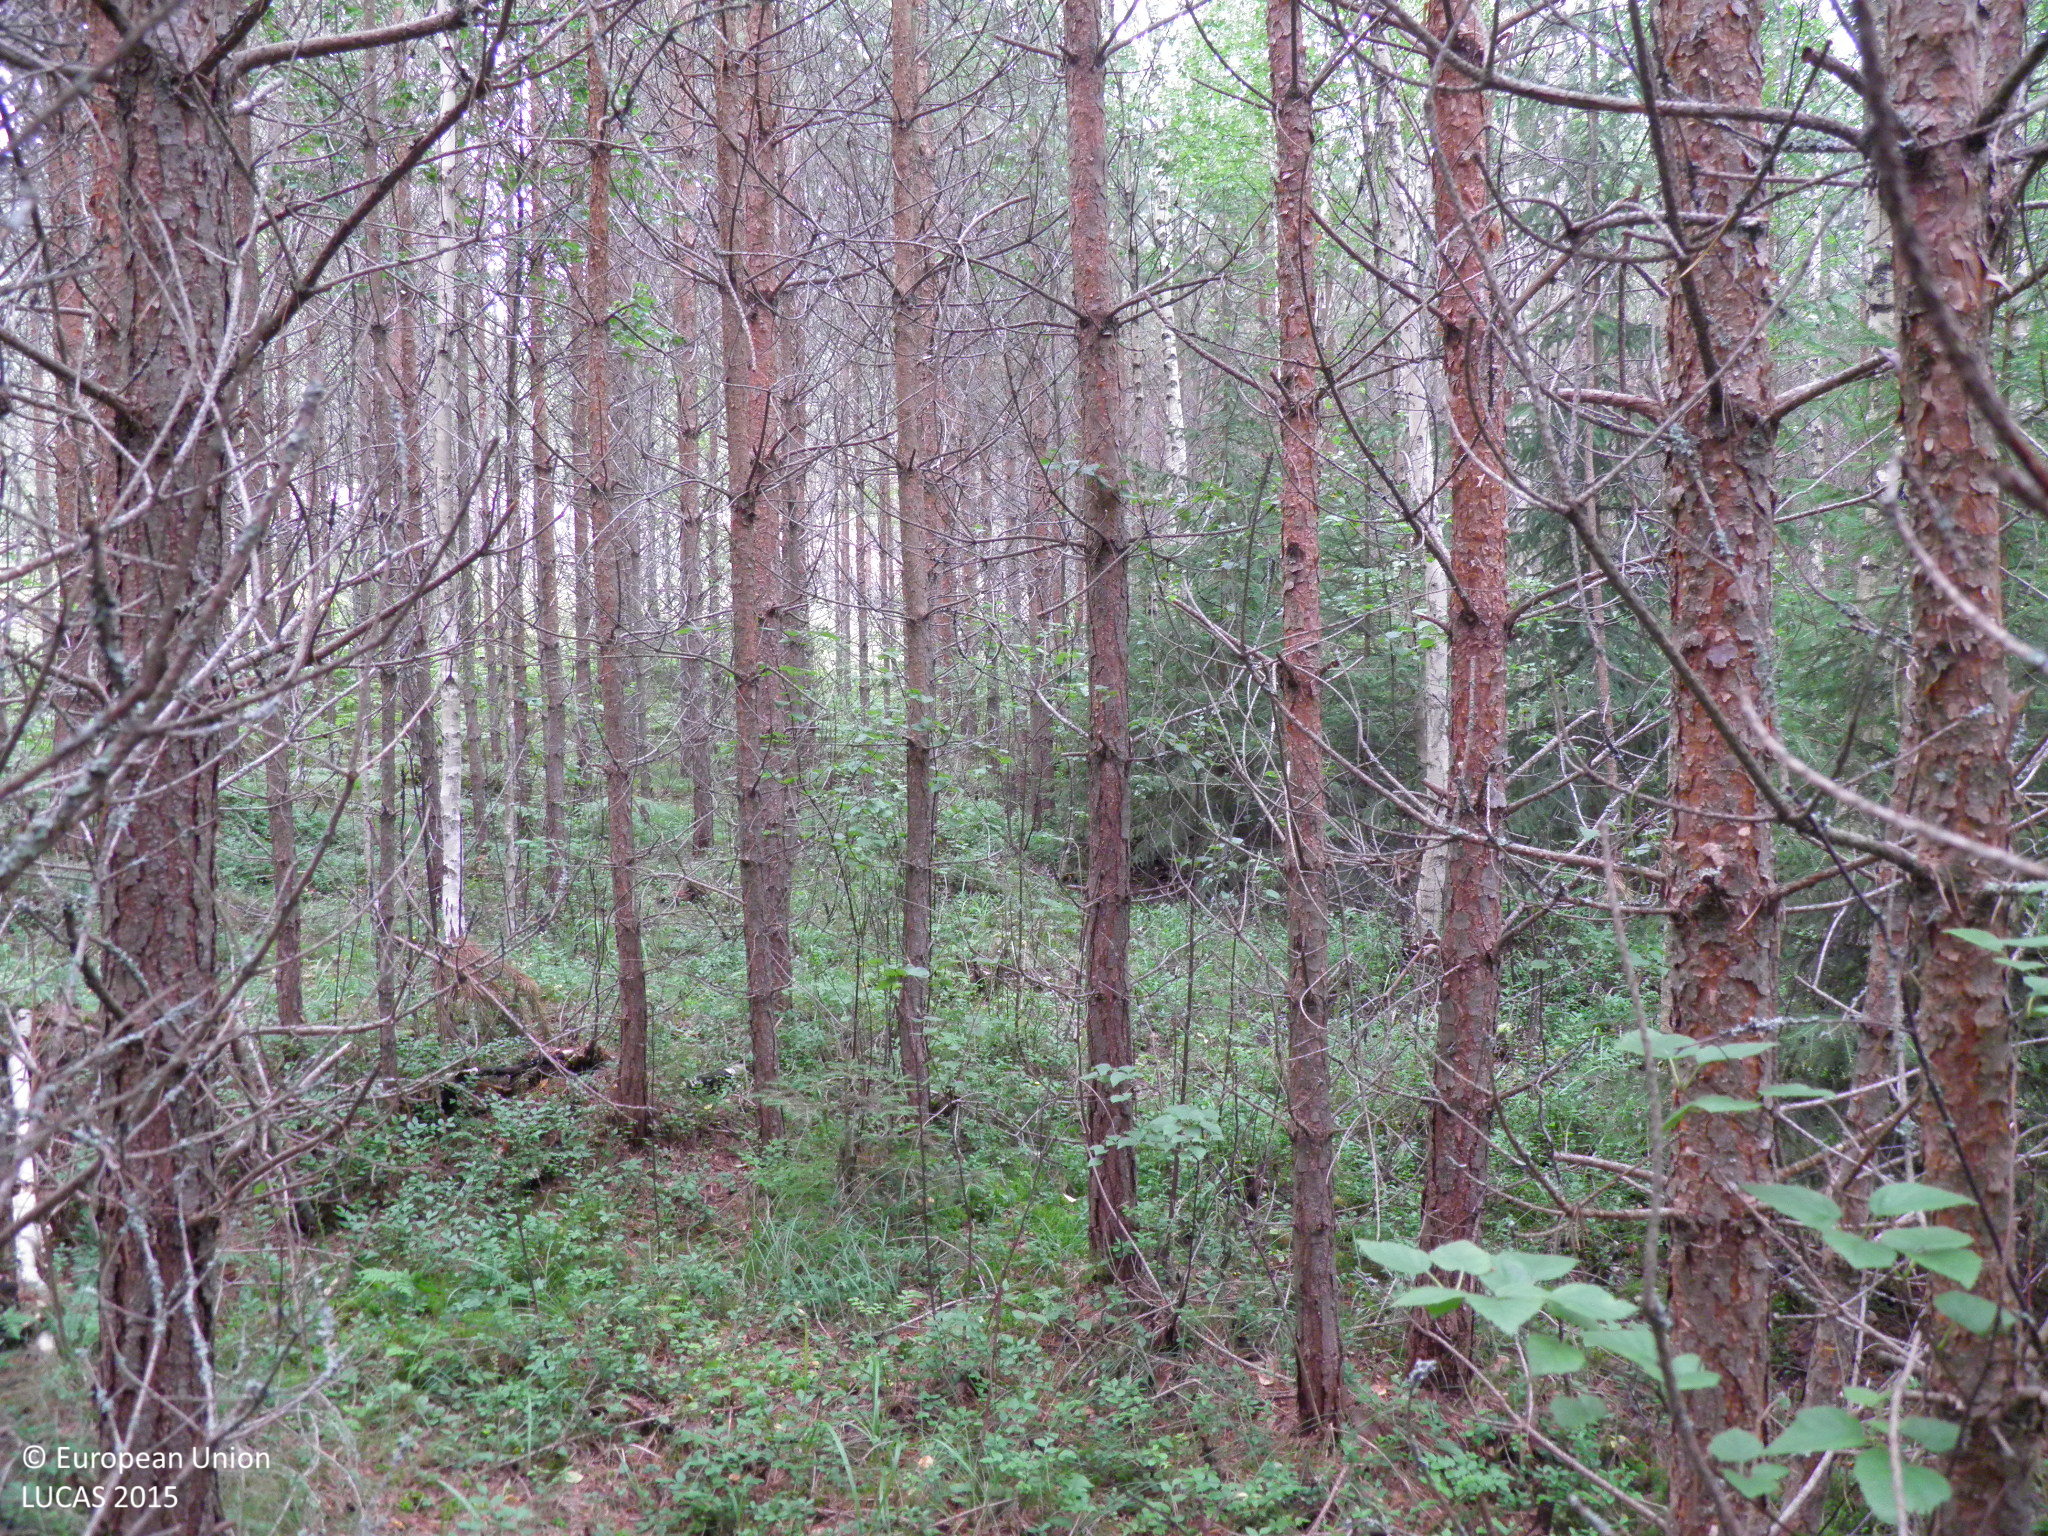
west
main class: Woodland
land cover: Pine dominated mixed woodland
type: hemiboreal forest and nemoral coniferous forest and mixed broadleaved-coniferous forest
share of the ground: > 75 %
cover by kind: coniferous forest trees 50 %, broadleaved forest trees 40 %, shrubs 5 %, herbaceous plants 5 %
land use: Forestry
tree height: > 5 m
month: July
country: FI
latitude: 60.1804
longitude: 22.7867
